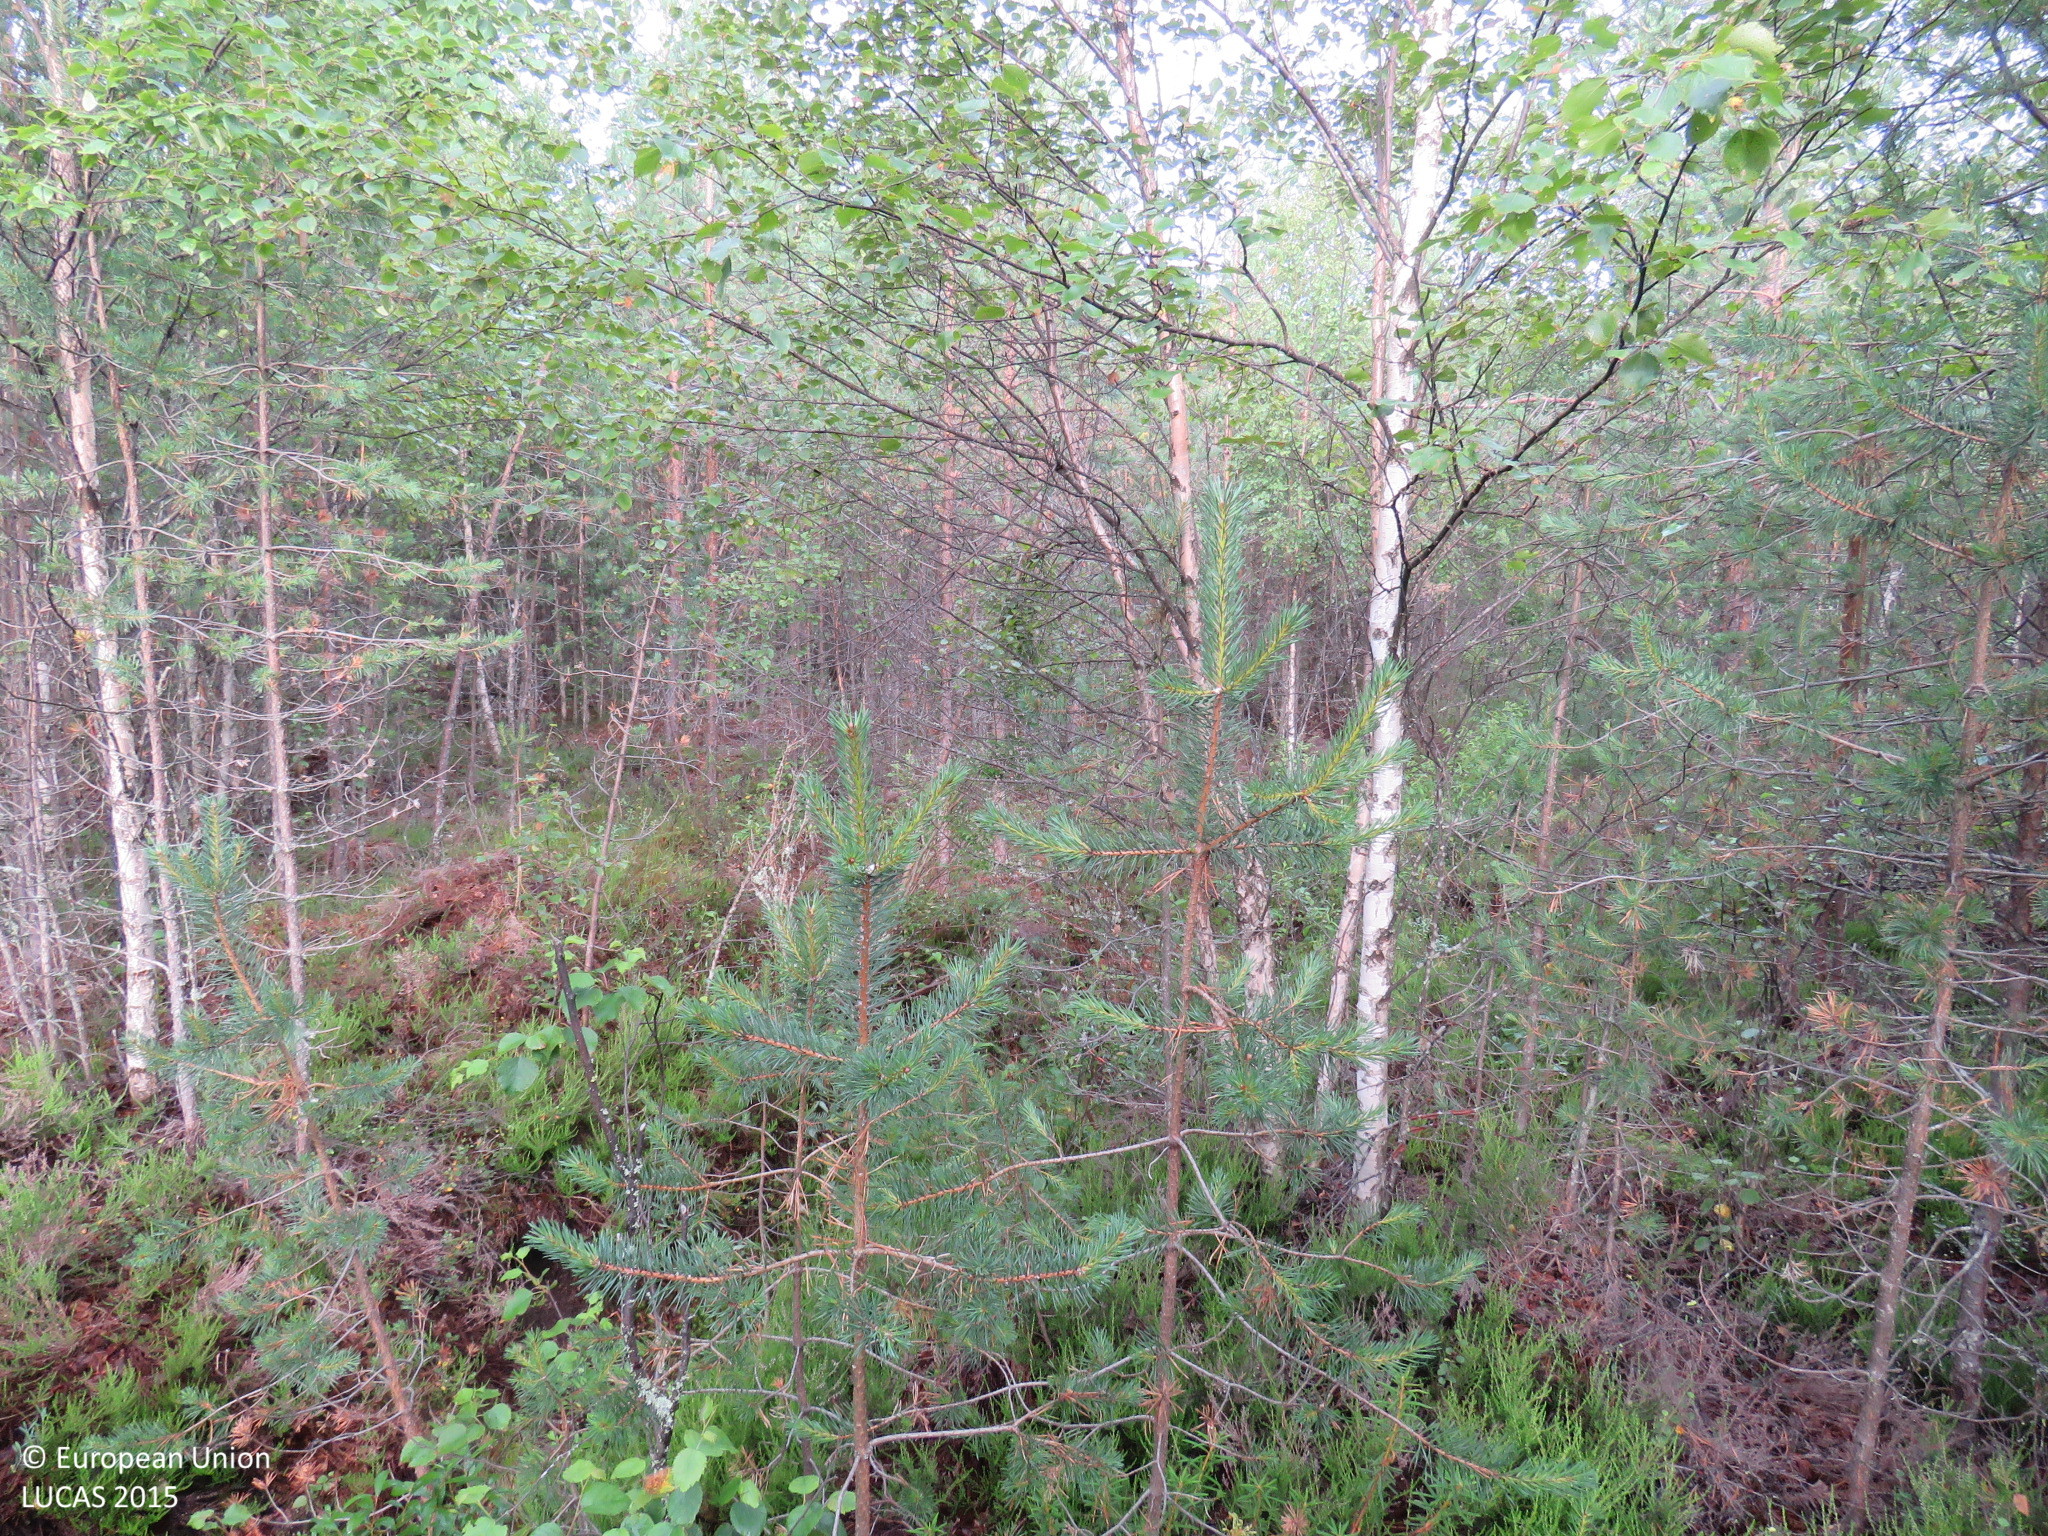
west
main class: Woodland
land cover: Pine dominated mixed woodland
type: mire and swamp forests
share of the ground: > 75 %
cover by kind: broadleaved forest trees 50 %, coniferous forest trees 40 %, shrubs 10 %
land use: Forestry
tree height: > 5 m
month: July
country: FI
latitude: 64.9162
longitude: 25.5827
